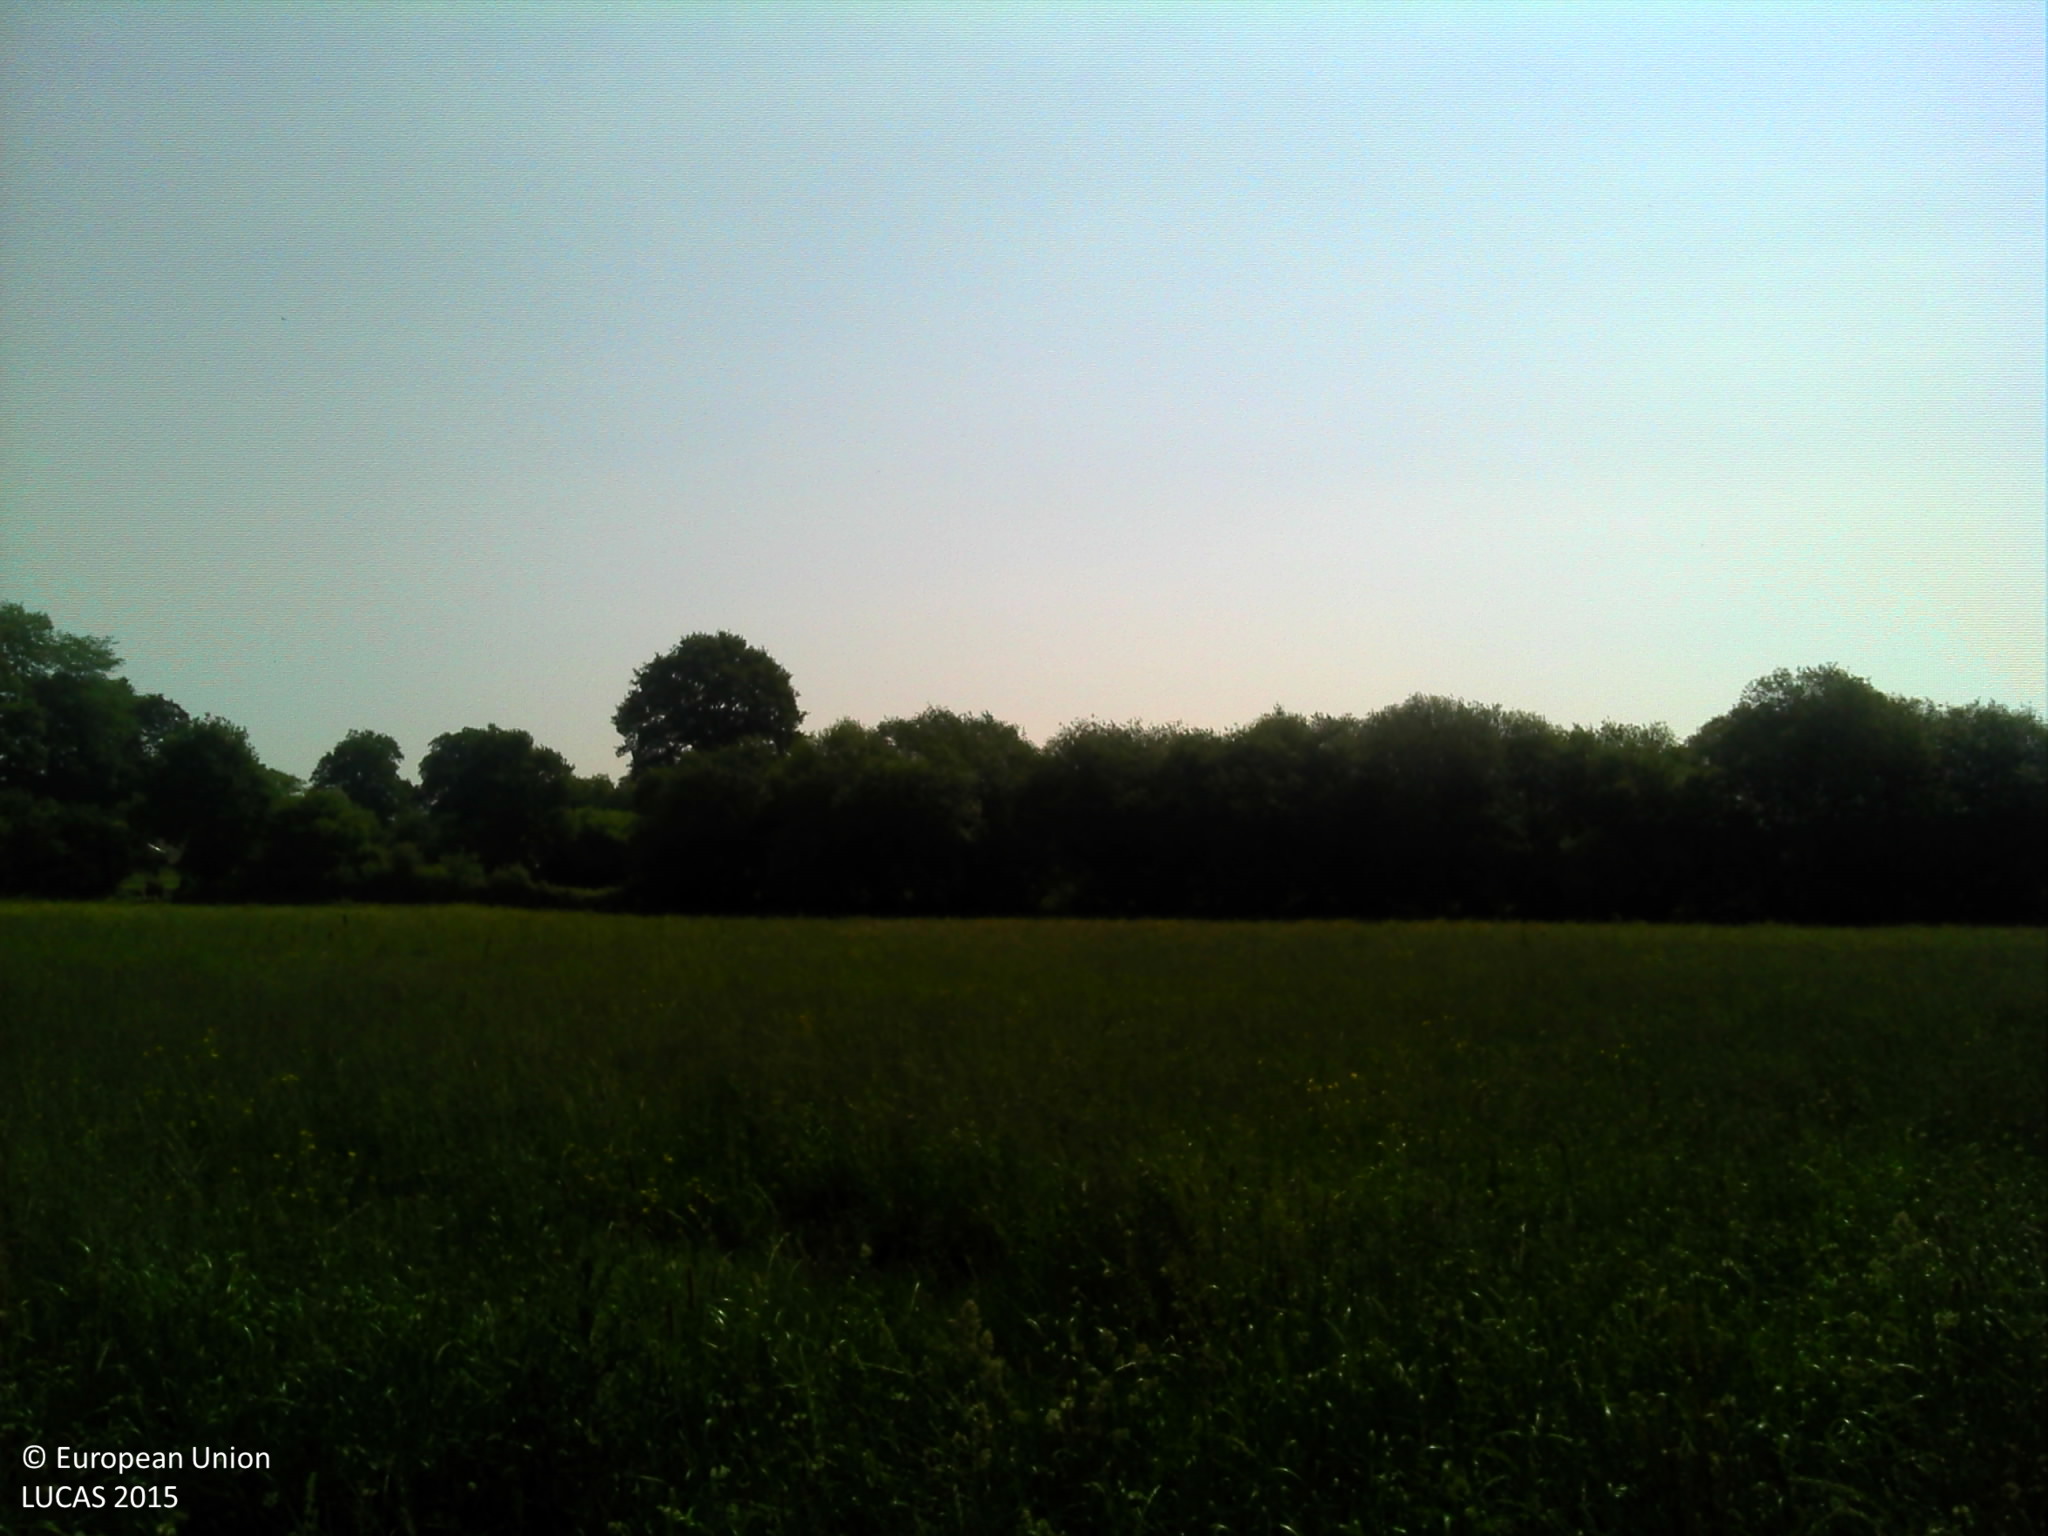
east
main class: Grassland
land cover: Grassland without tree/shrub cover
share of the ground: > 75 %
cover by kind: herbaceous plants 100 %
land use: Agriculture (excluding fallow land and kitchen gardens)
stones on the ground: < 10 %
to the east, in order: Grassland without tree/shrub cover; Fences; Grassland without tree/shrub cover; Fences; Broadleaved woodland; Shruby margins; Fences; Grassland without tree/shrub cover; Fences; Grassland without tree/shrub cover; Fences; Grassland without tree/shrub cover
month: June
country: FR
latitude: 47.8597
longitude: 0.0147
